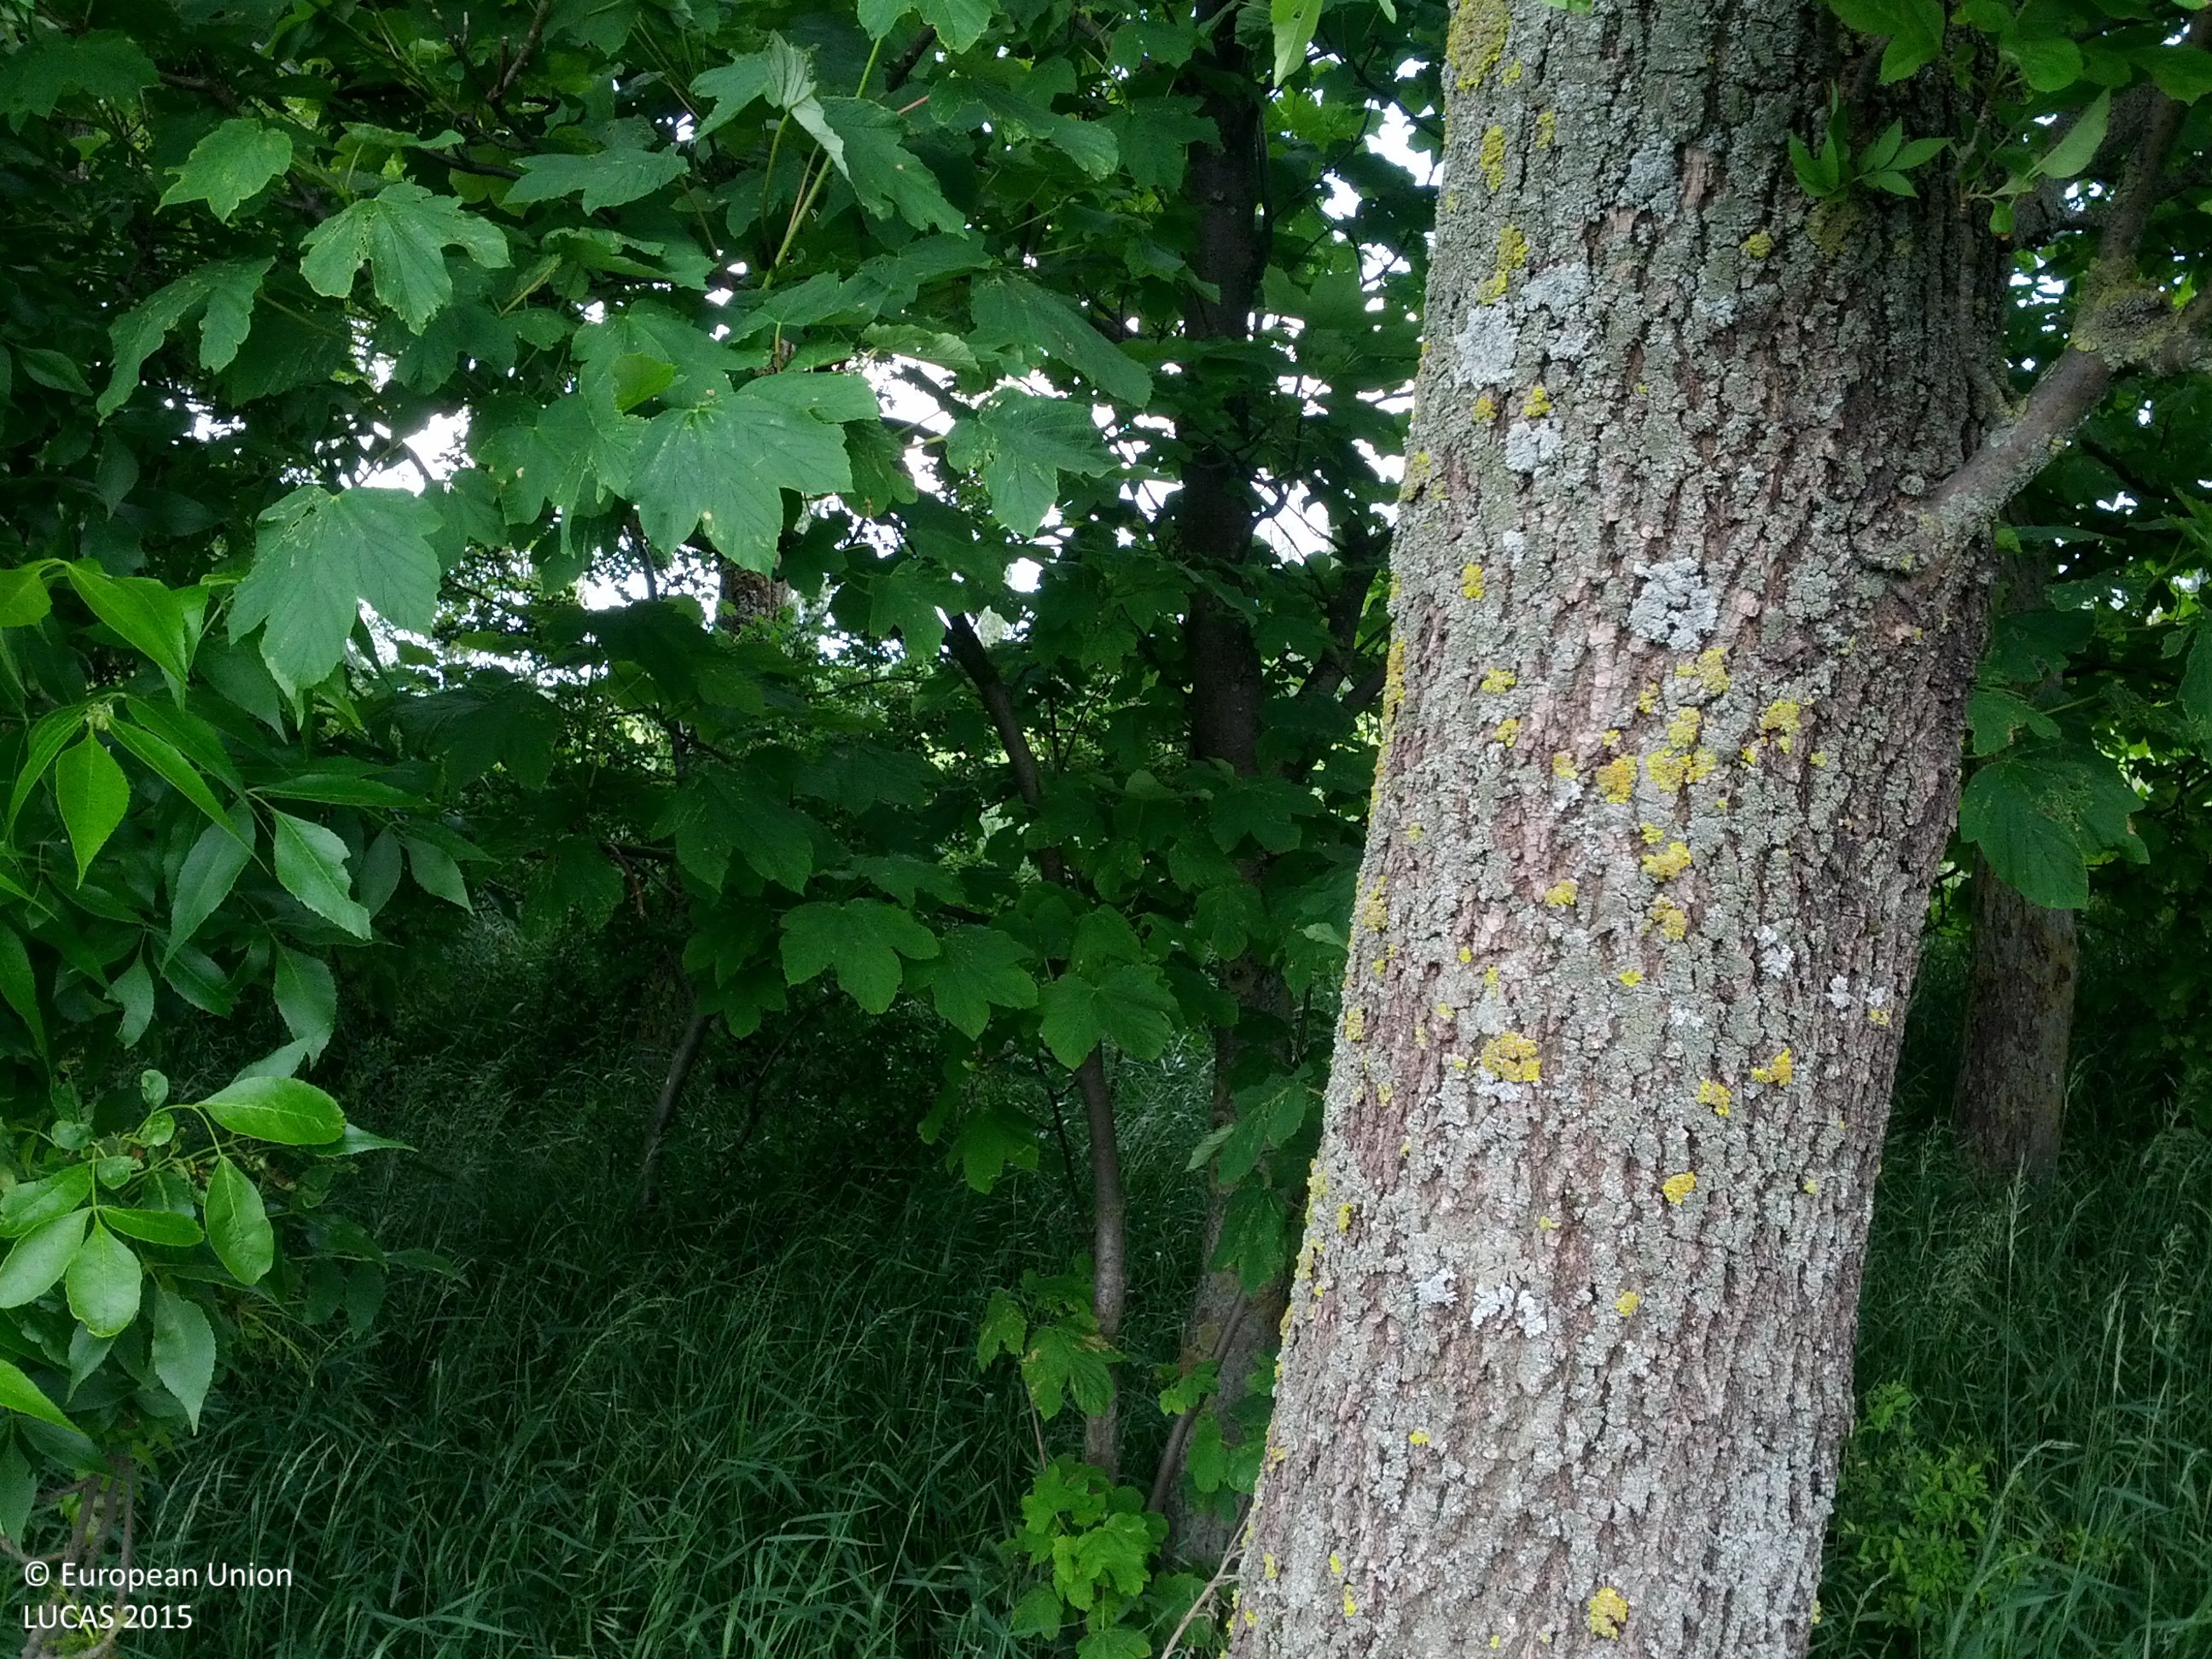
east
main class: Cropland
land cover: Common wheat
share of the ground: > 75 %
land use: Agriculture (excluding fallow land and kitchen gardens)
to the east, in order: Common wheat; Broadleaved woodland; Tracks; Grass margins; Sugar beet; Grass margins; Lines of trees; Tracks; Grass margins; Maize
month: May
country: AT
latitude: 48.0458
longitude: 16.8614
